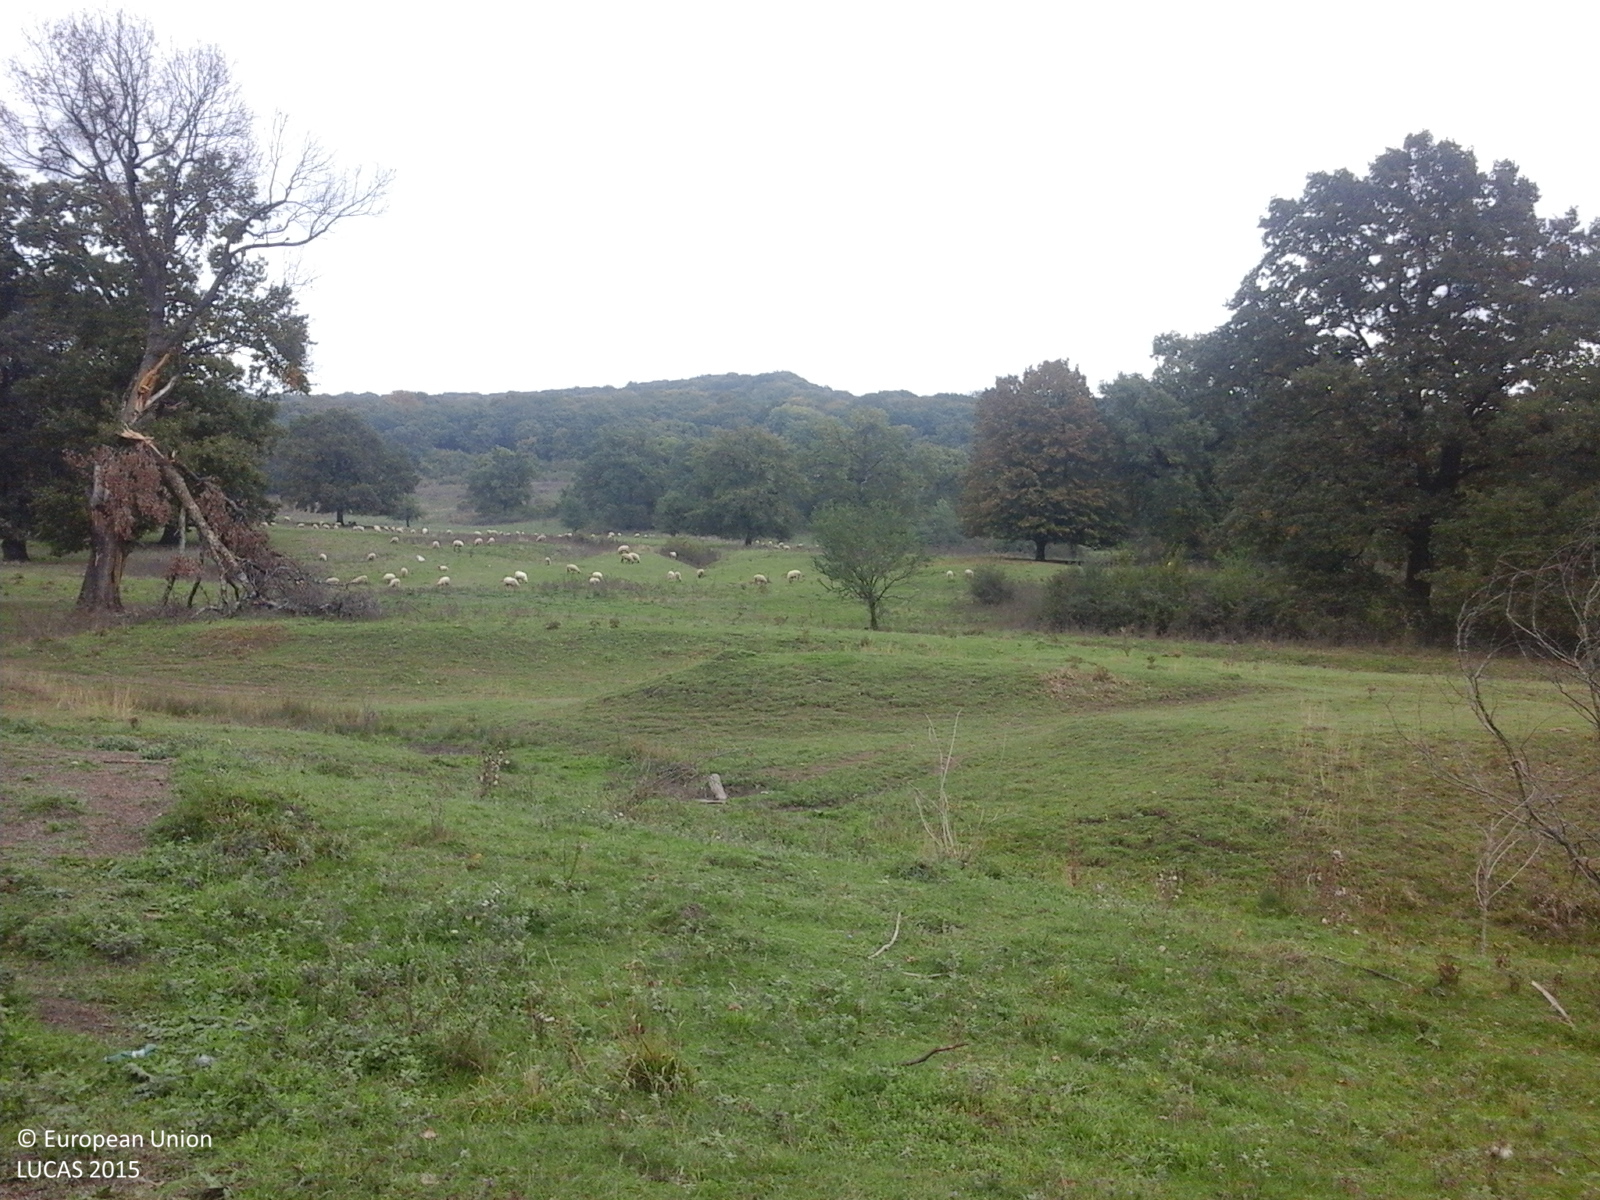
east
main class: Grassland
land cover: Grassland with sparse tree/shrub cover
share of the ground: > 75 %
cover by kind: herbaceous plants 85 %, shrubs 10 %, broadleaved forest trees 5 %
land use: Agriculture (excluding fallow land and kitchen gardens)
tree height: > 5 m
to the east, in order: Grassland with sparse tree/shrub cover; Broadleaved woodland
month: October
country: RO
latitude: 46.1545
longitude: 24.8133
